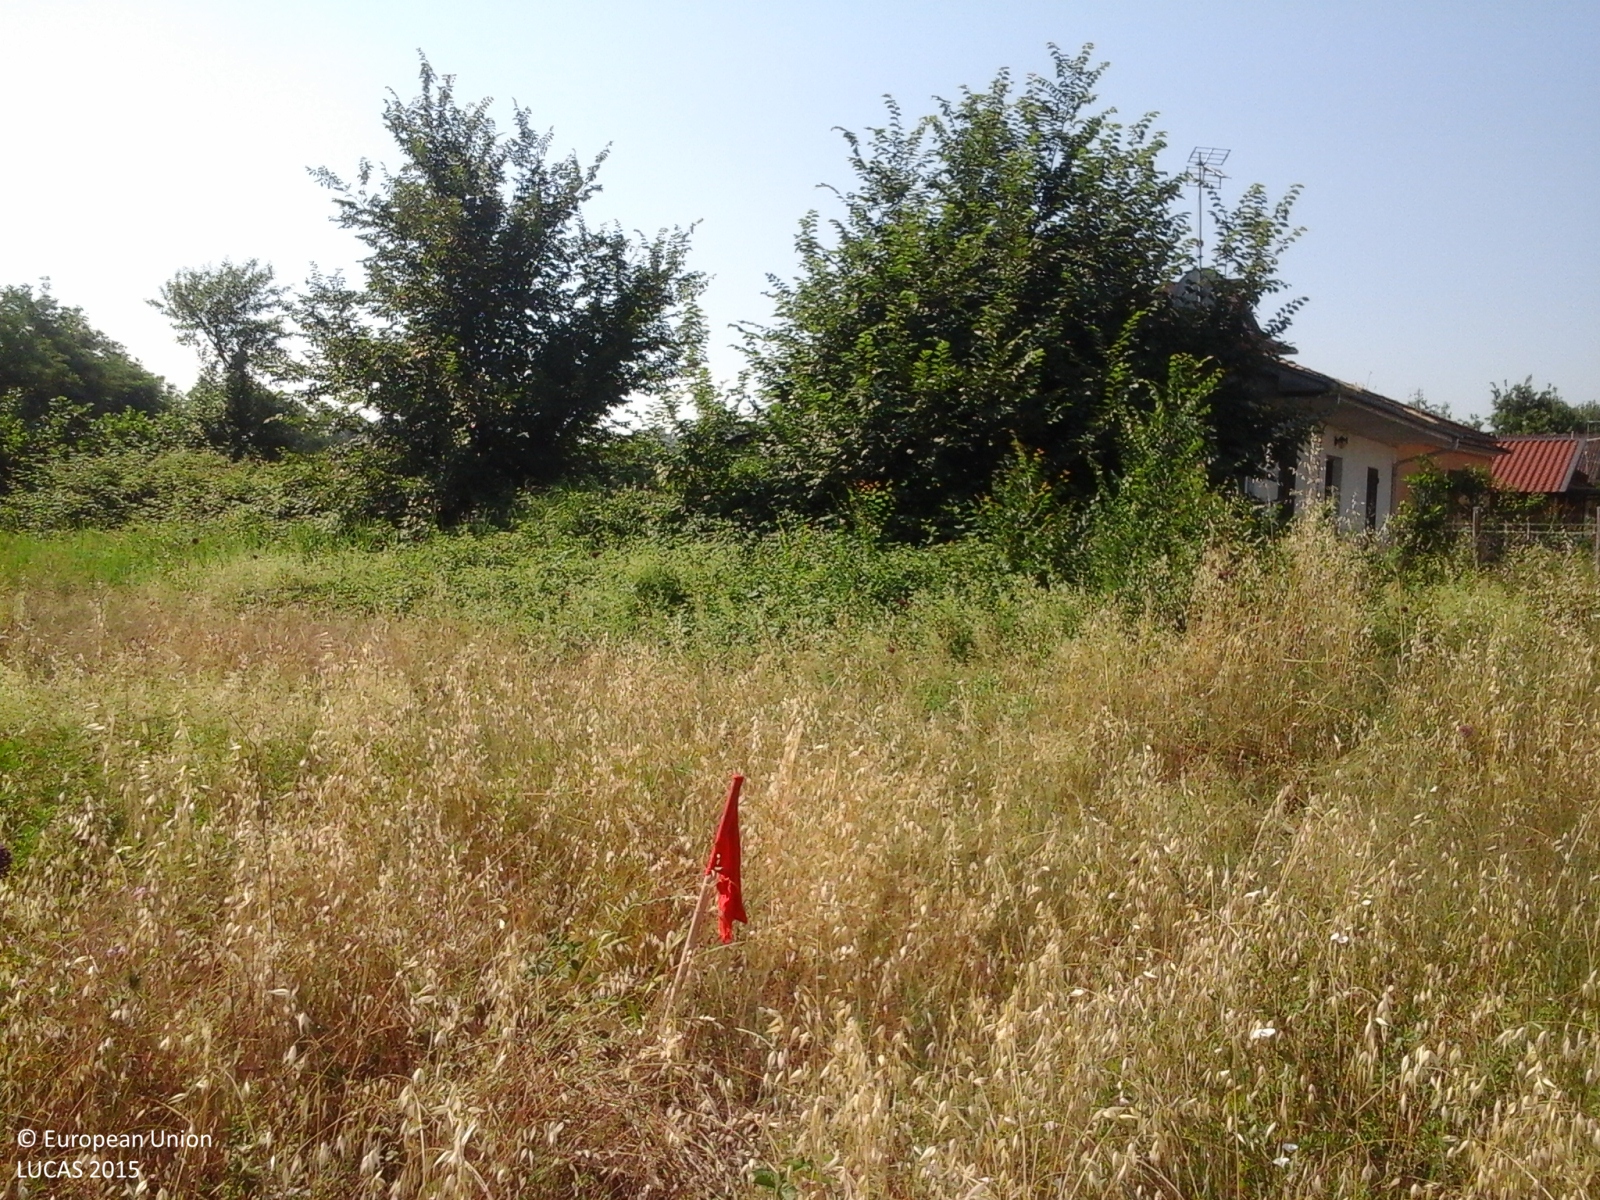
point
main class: Grassland
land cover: Grassland without tree/shrub cover
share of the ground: > 75 %
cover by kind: herbaceous plants 100 %
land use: Agriculture (excluding fallow land and kitchen gardens)
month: May
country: IT
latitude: 41.6407
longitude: 13.3369
